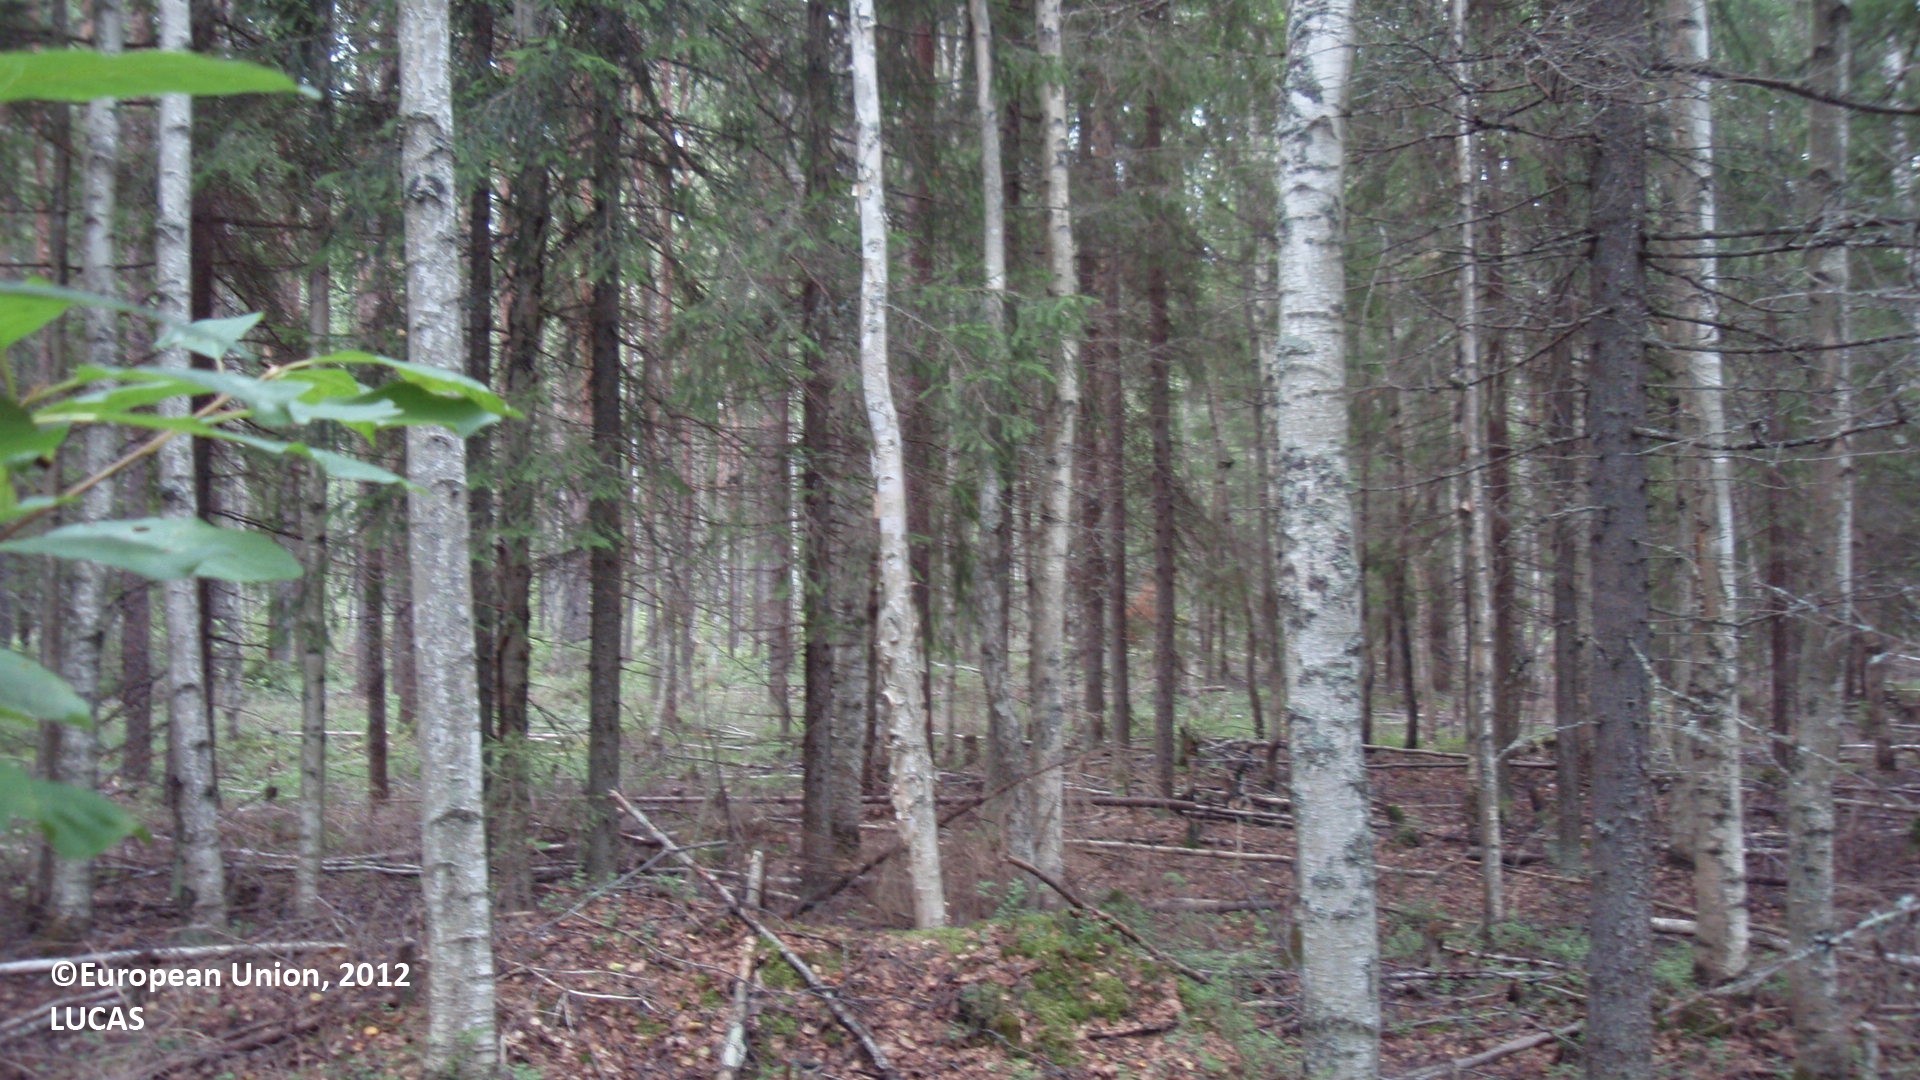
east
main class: Woodland
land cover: Other coniferous woodland
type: boreal forest
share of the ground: > 75 %
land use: Forestry
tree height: > 5 m
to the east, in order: Other coniferous woodland; Ditches and canals; Other coniferous woodland; Ditches and canals; Other coniferous woodland; Ditches and canals; Spruce dominated mixed woodland; Ditches and canals; Other coniferous woodland; Ditches and canals; Pine dominated mixed woodland; Ditches and canals; Other coniferous woodland; Ditches and canals; Other coniferous woodland
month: August
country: FI
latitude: 61.1200
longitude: 27.4217
